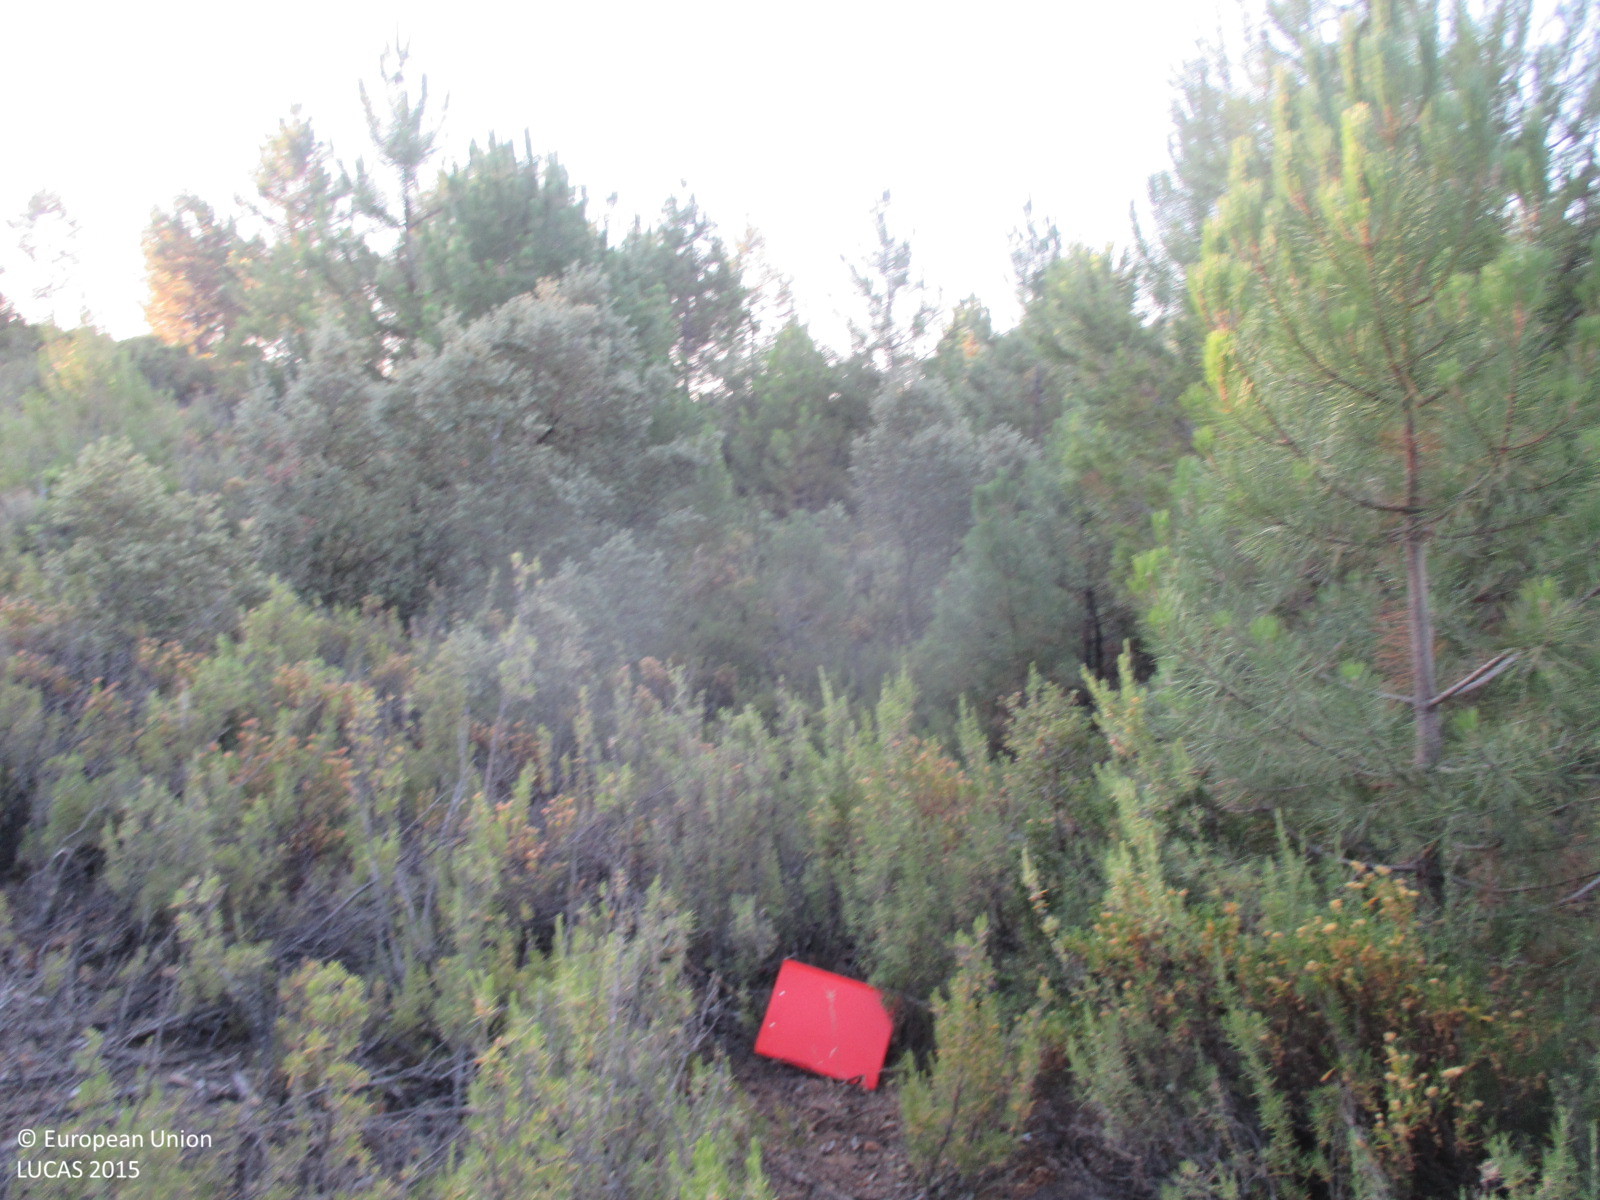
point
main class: Woodland
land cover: Pine dominated coniferous woodland
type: coniferous forest of the mediterranean region
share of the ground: 25 - 50 %
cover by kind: coniferous forest trees 40 %, shrubs 40 %, herbaceous plants 20 %
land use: Forestry
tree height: > 5 m
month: July
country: ES
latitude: 38.3447
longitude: -2.3875
